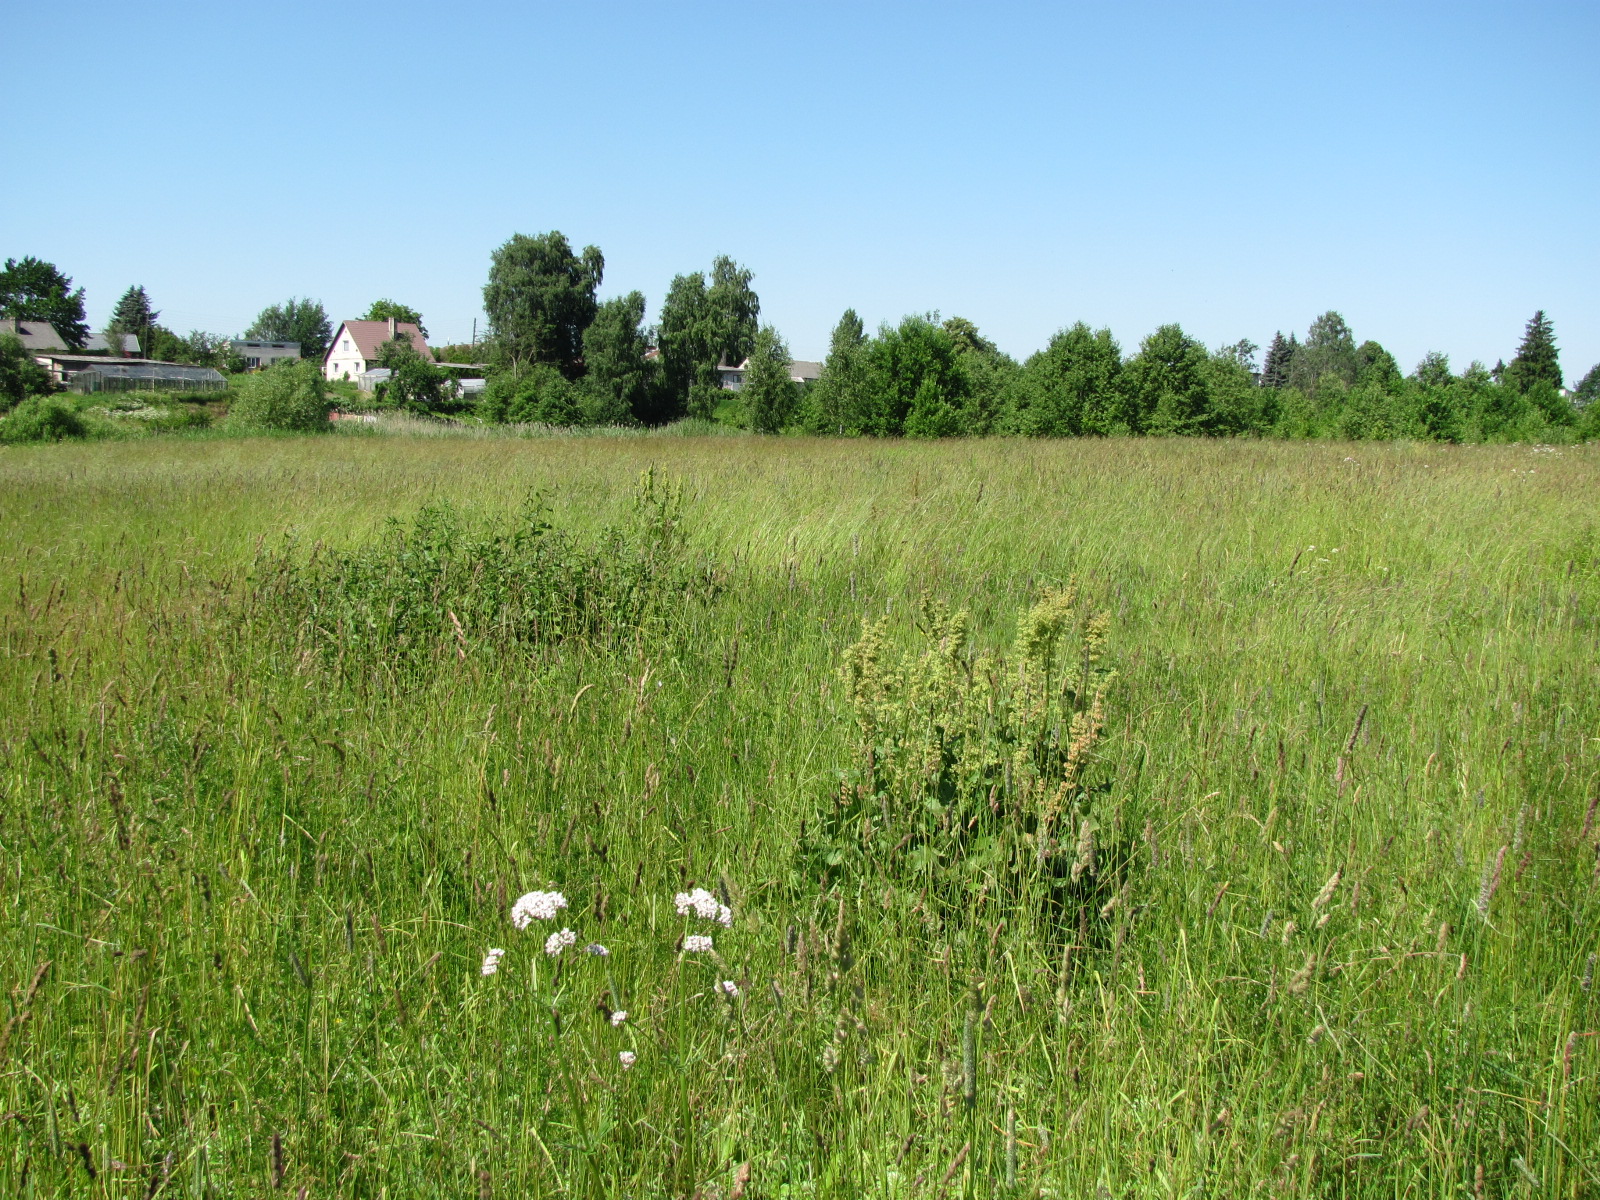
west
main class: Grassland
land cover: Grassland with sparse tree/shrub cover
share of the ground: > 75 %
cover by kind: herbaceous plants 95 %, broadleaved forest trees 5 %
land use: Abandoned areas
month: July
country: LV
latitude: 56.8763
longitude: 24.1820
